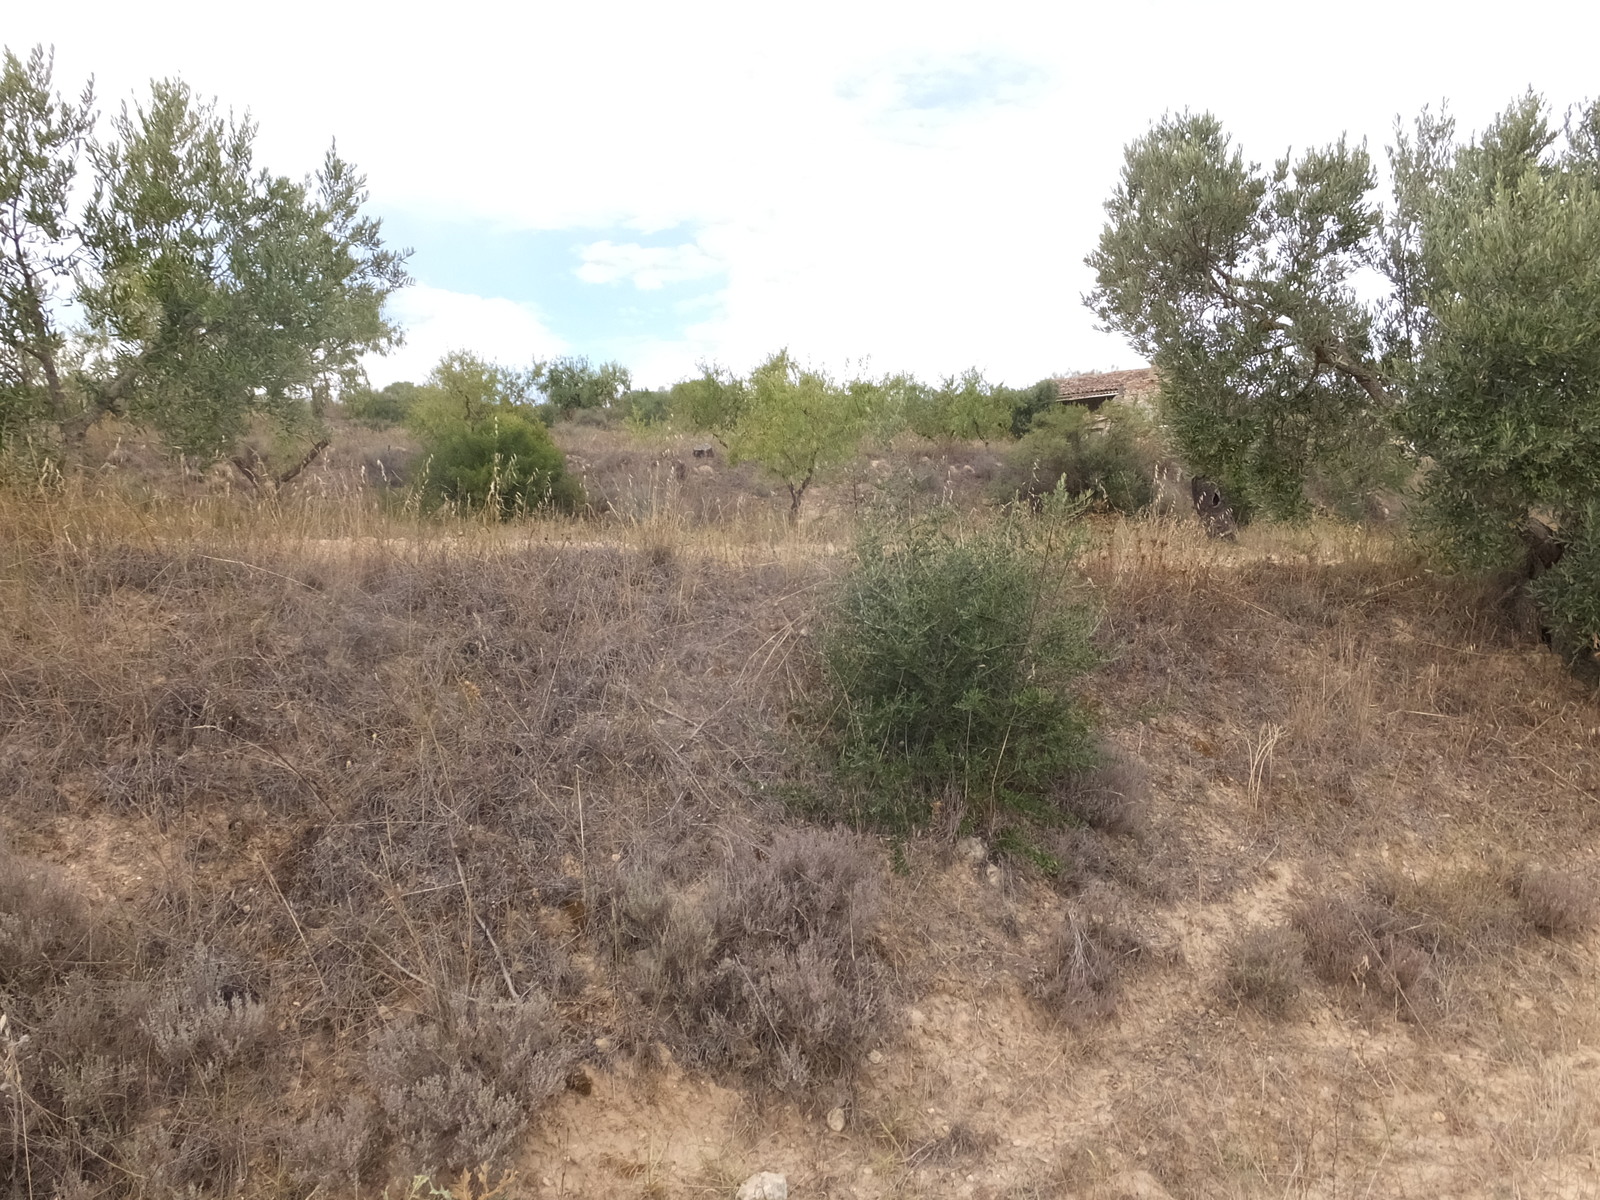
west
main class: Cropland
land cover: Nuts trees
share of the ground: > 75 %
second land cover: Other bare soil
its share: > 75 %
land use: Agriculture (excluding fallow land and kitchen gardens)
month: August
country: ES
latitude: 41.3326
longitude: 0.2980
